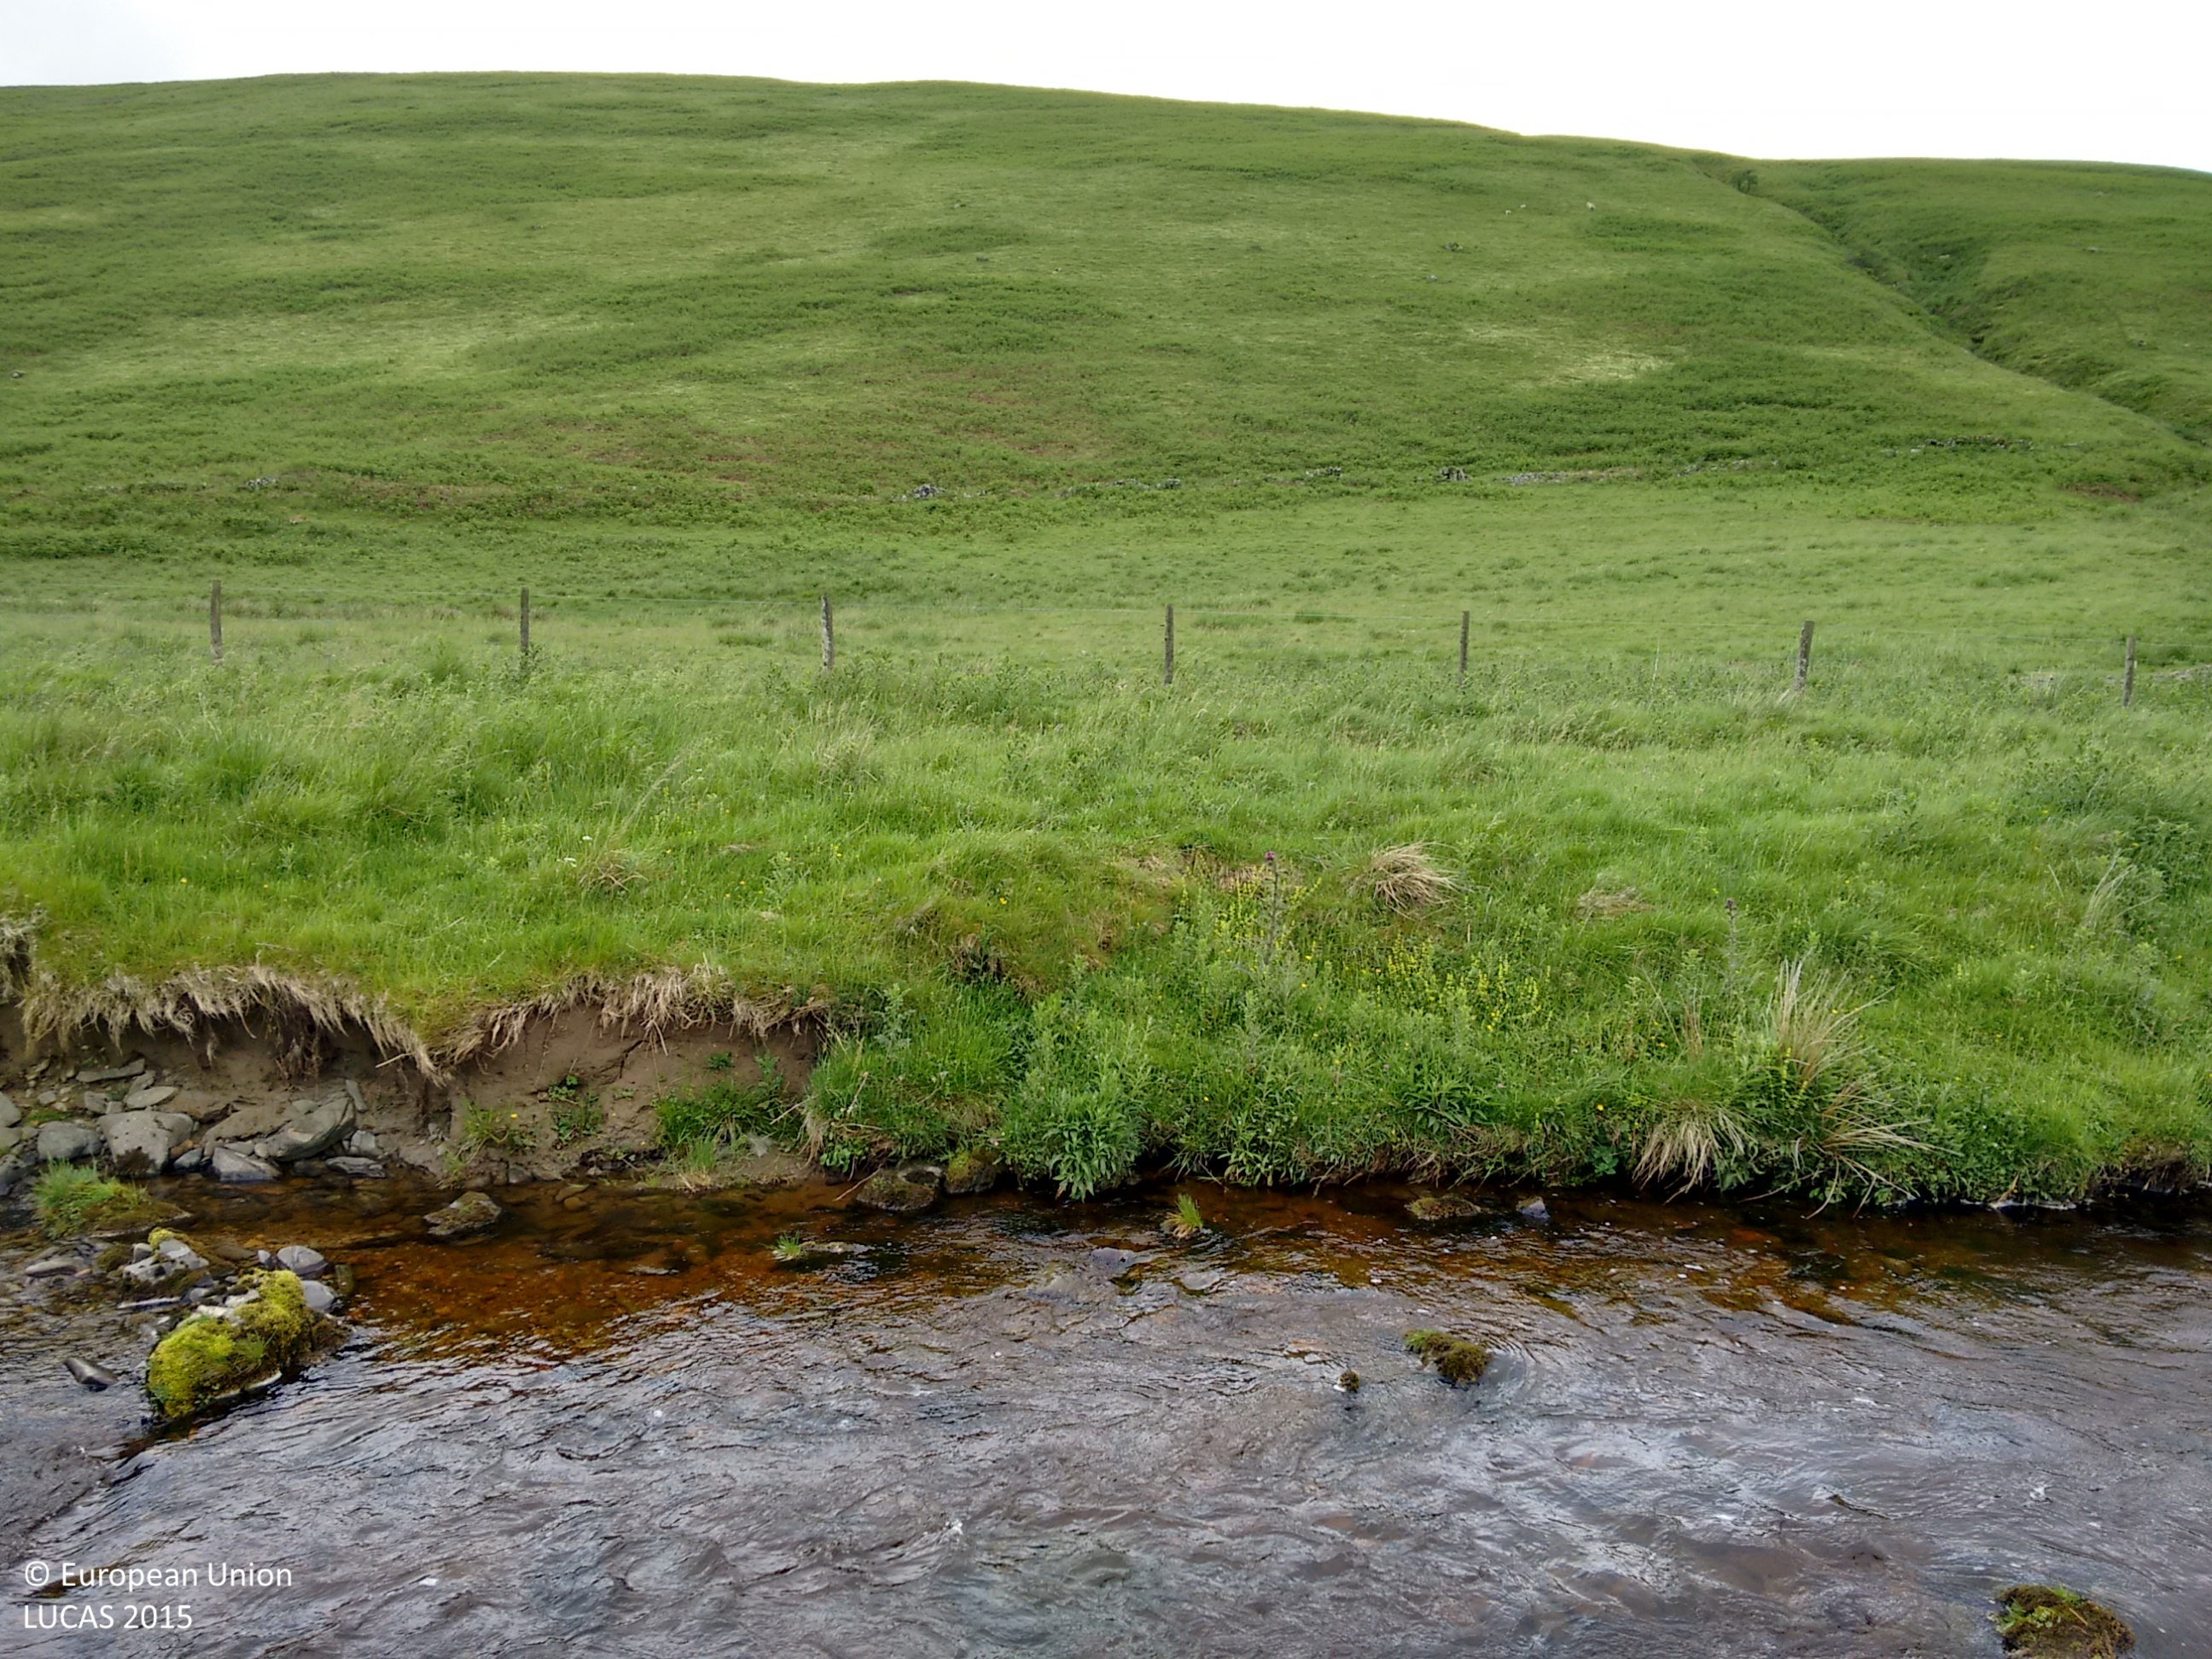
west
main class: Grassland
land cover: Grassland without tree/shrub cover
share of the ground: > 75 %
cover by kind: herbaceous plants 100 %
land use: Agriculture (excluding fallow land and kitchen gardens)
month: June
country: GB
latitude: 55.2378
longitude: -3.1095
